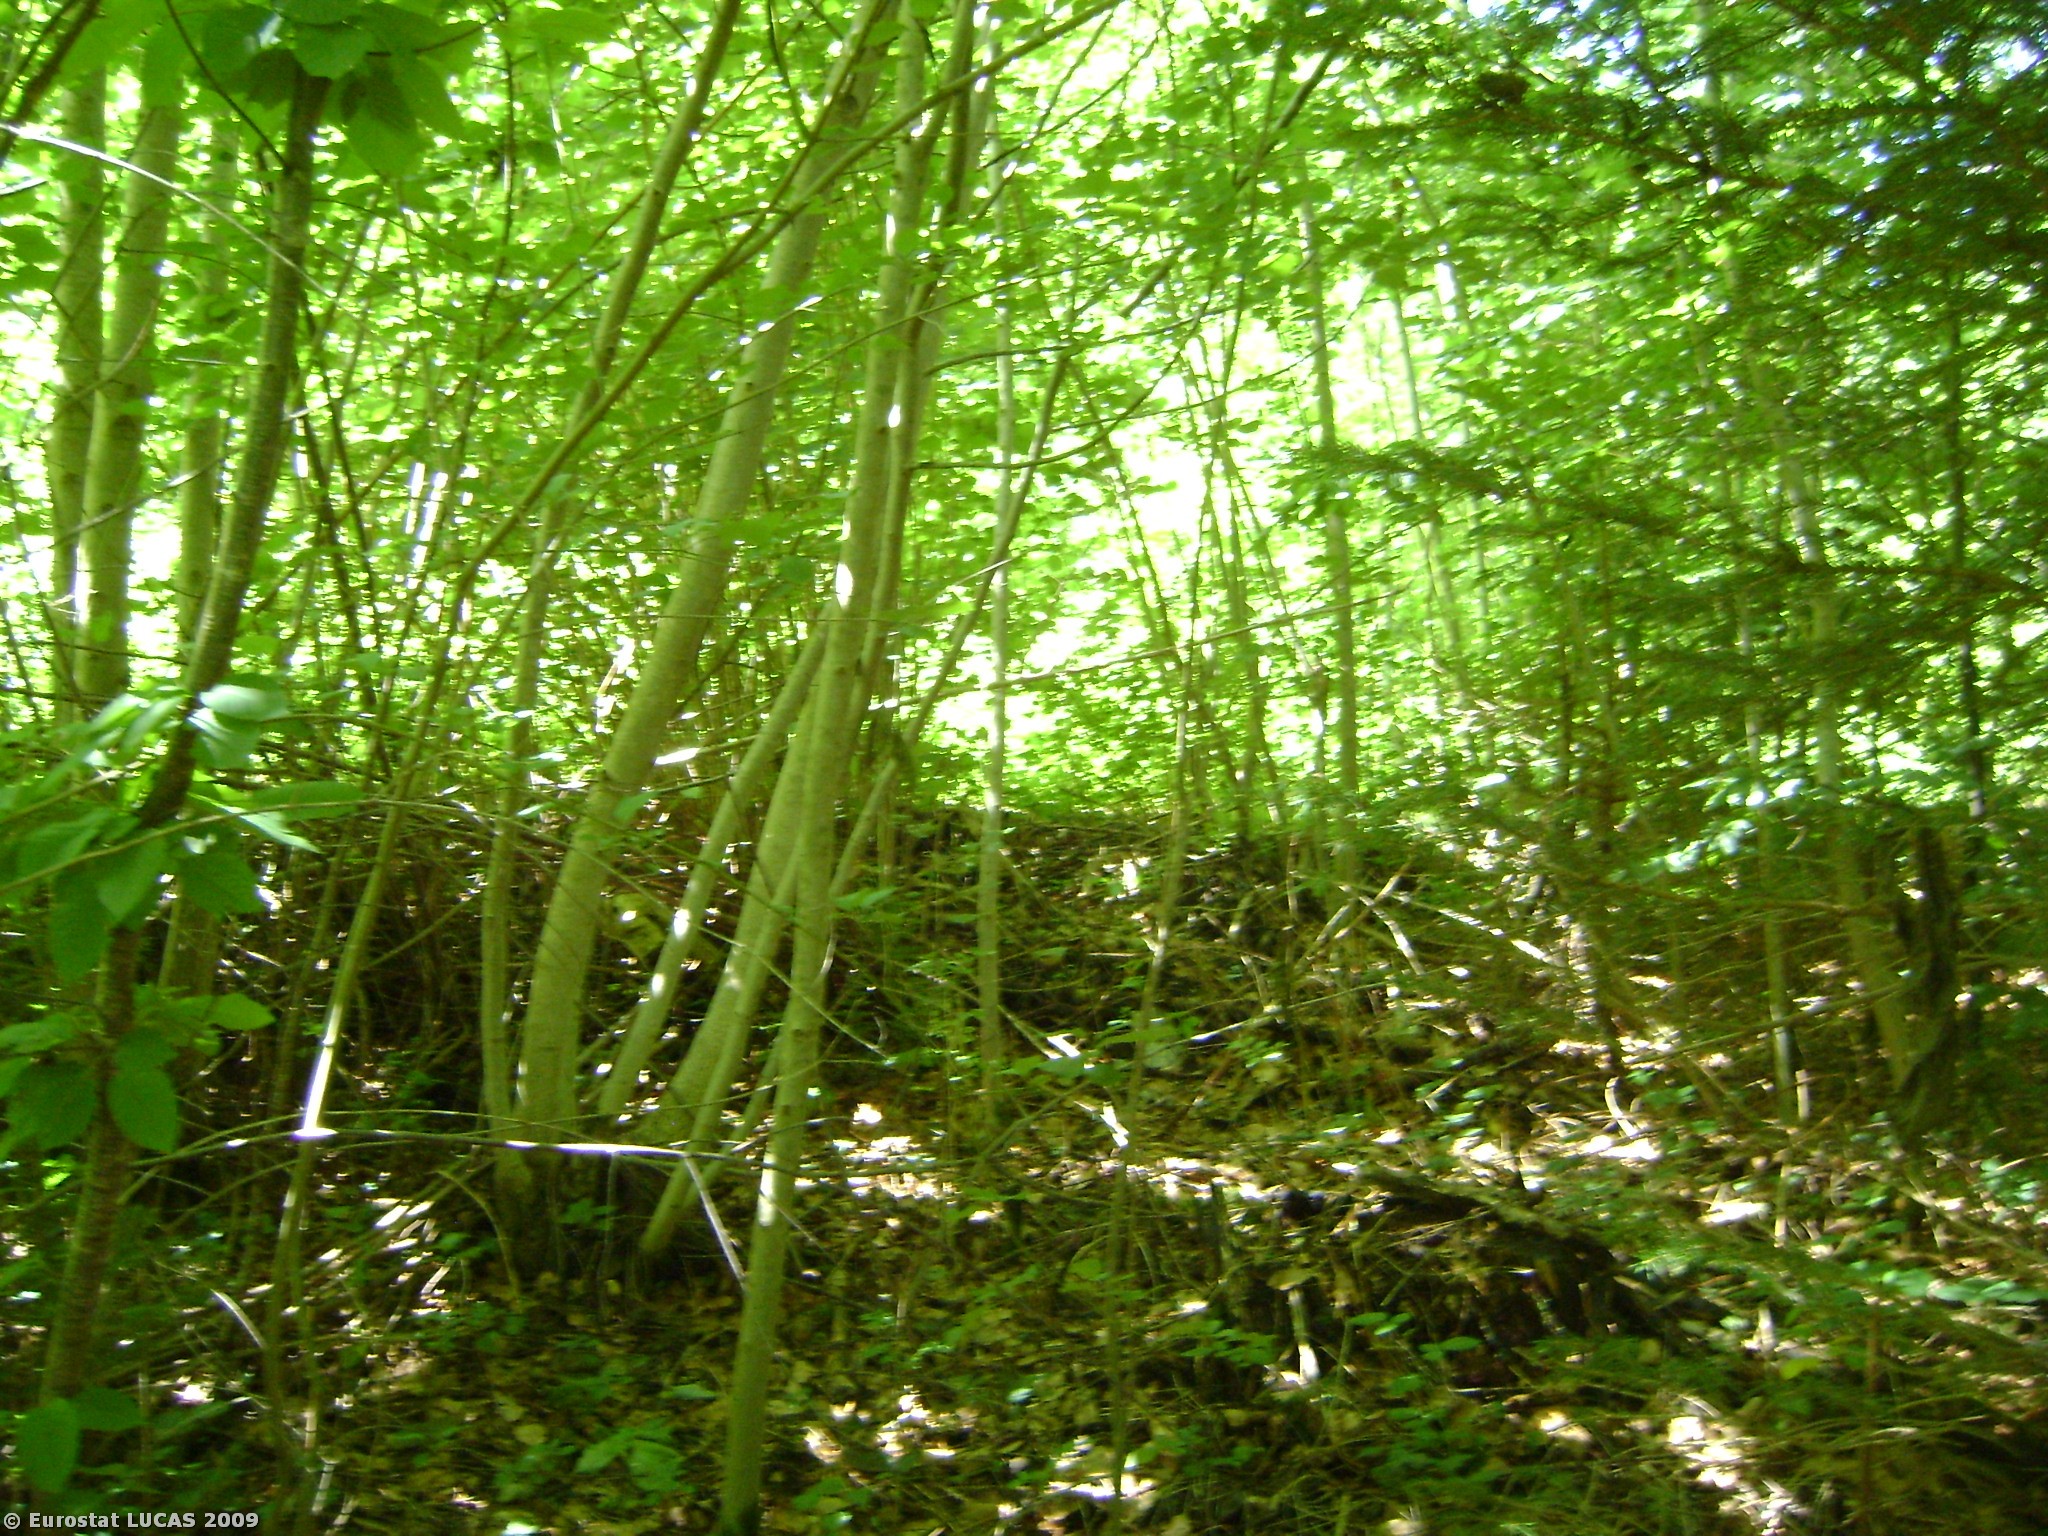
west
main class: Woodland
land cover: Broadleaved woodland
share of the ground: > 75 %
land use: Forestry
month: July
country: AT
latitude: 47.1971
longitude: 9.6703
